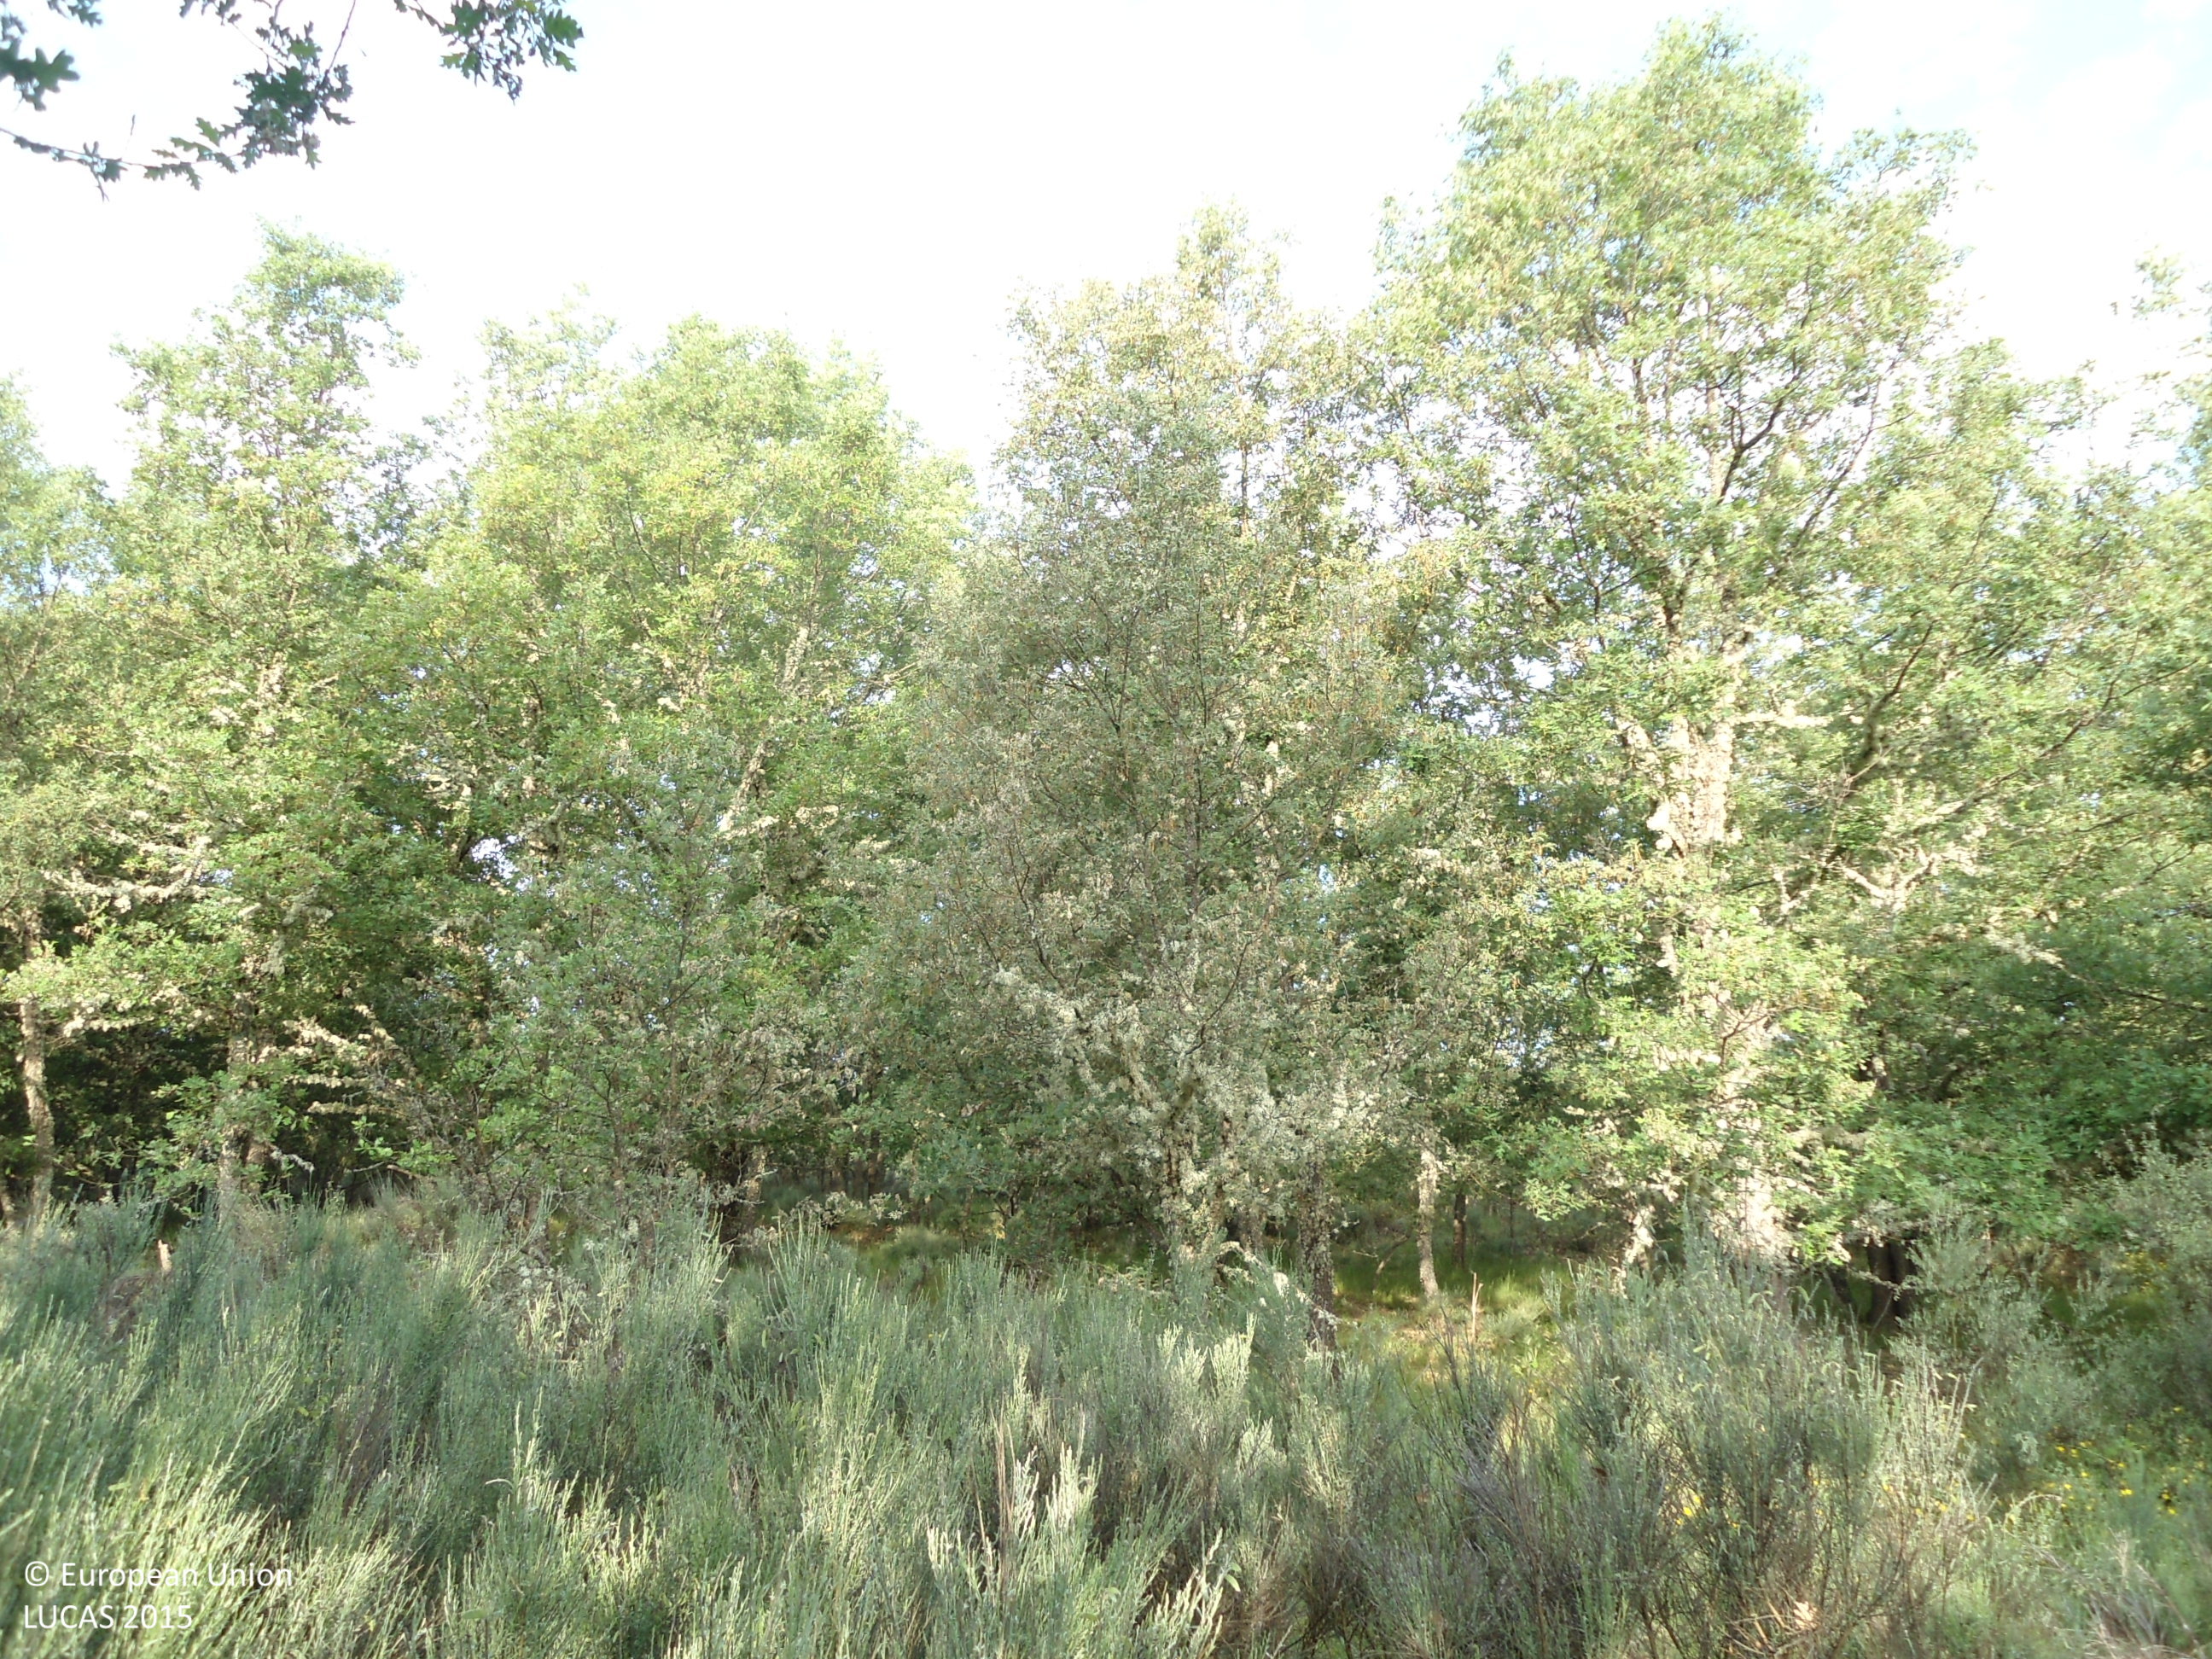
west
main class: Woodland
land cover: Broadleaved woodland
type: broadleaved evergreen forest
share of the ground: > 75 %
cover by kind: broadleaved forest trees 75 %, shrubs 20 %, herbaceous plants 5 %
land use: Forestry
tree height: > 5 m
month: June
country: ES
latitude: 42.0627
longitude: -6.6088
